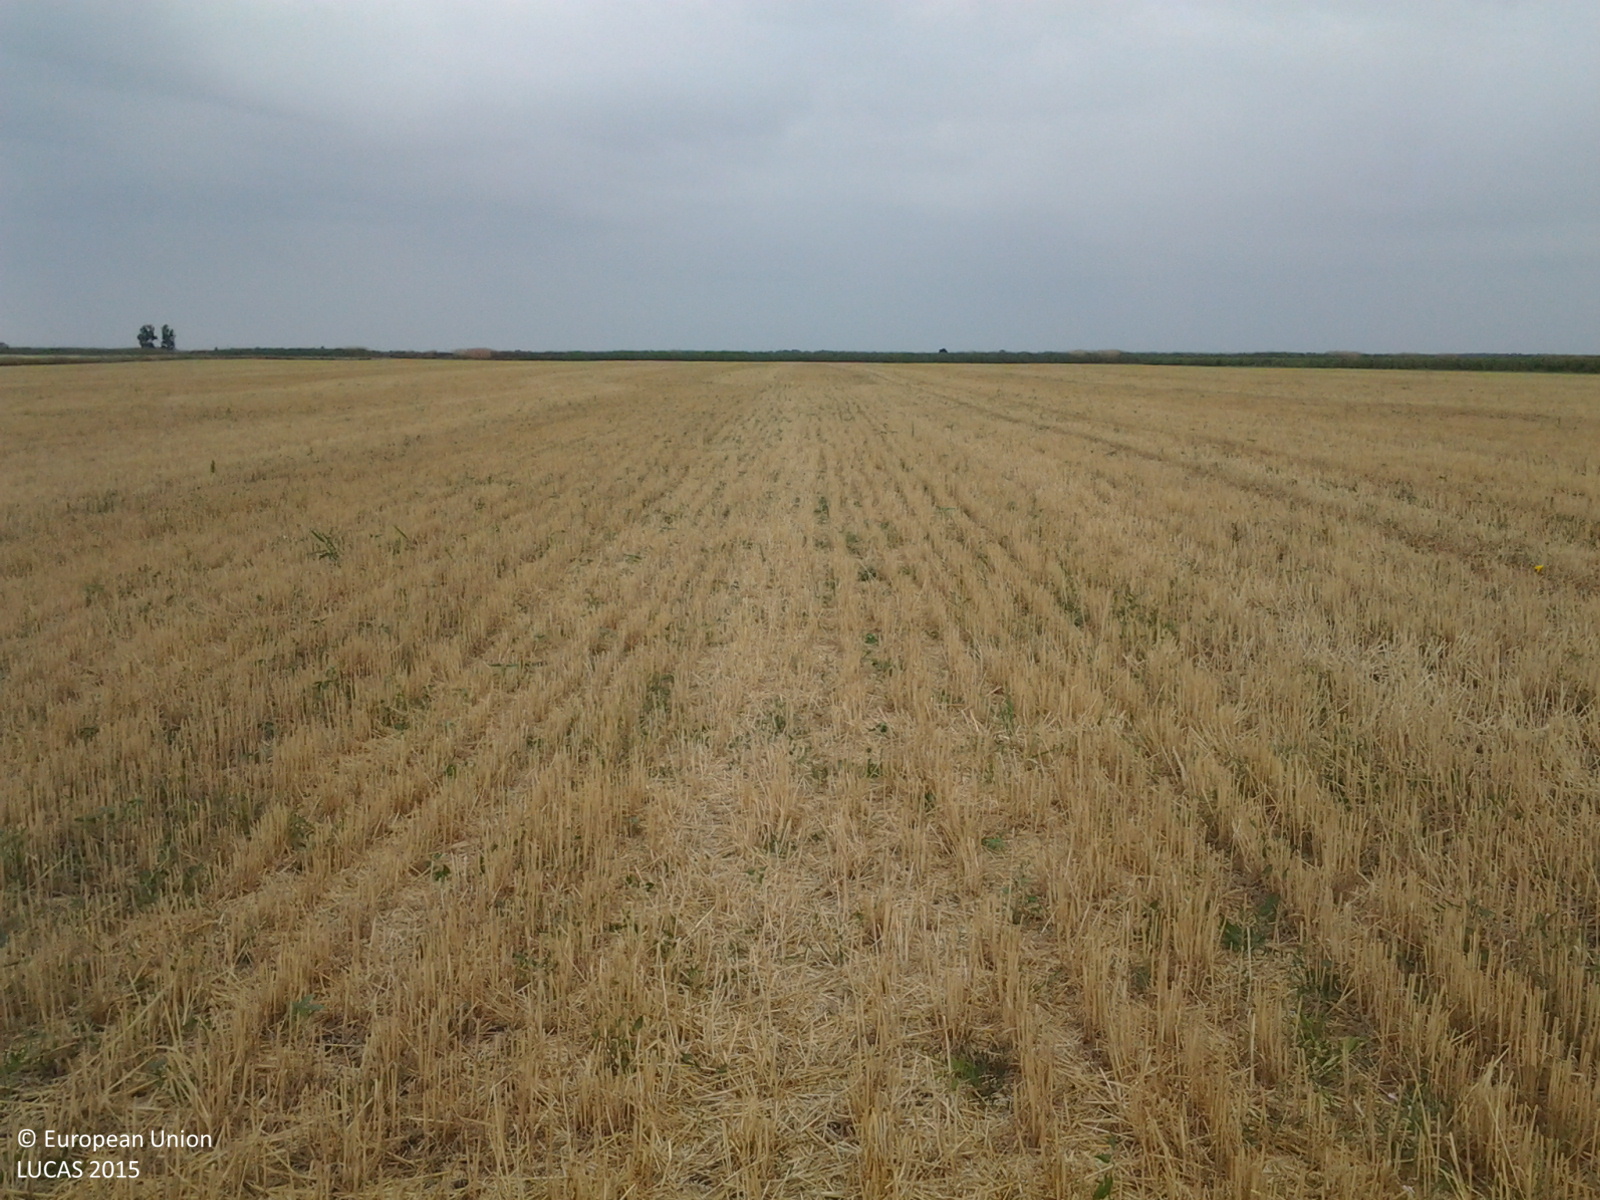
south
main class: Cropland
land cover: Common wheat
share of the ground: < 10 %
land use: Agriculture (excluding fallow land and kitchen gardens)
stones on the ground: < 10 %
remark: Harvested field
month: July
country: HU
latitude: 47.2883
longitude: 20.8364
